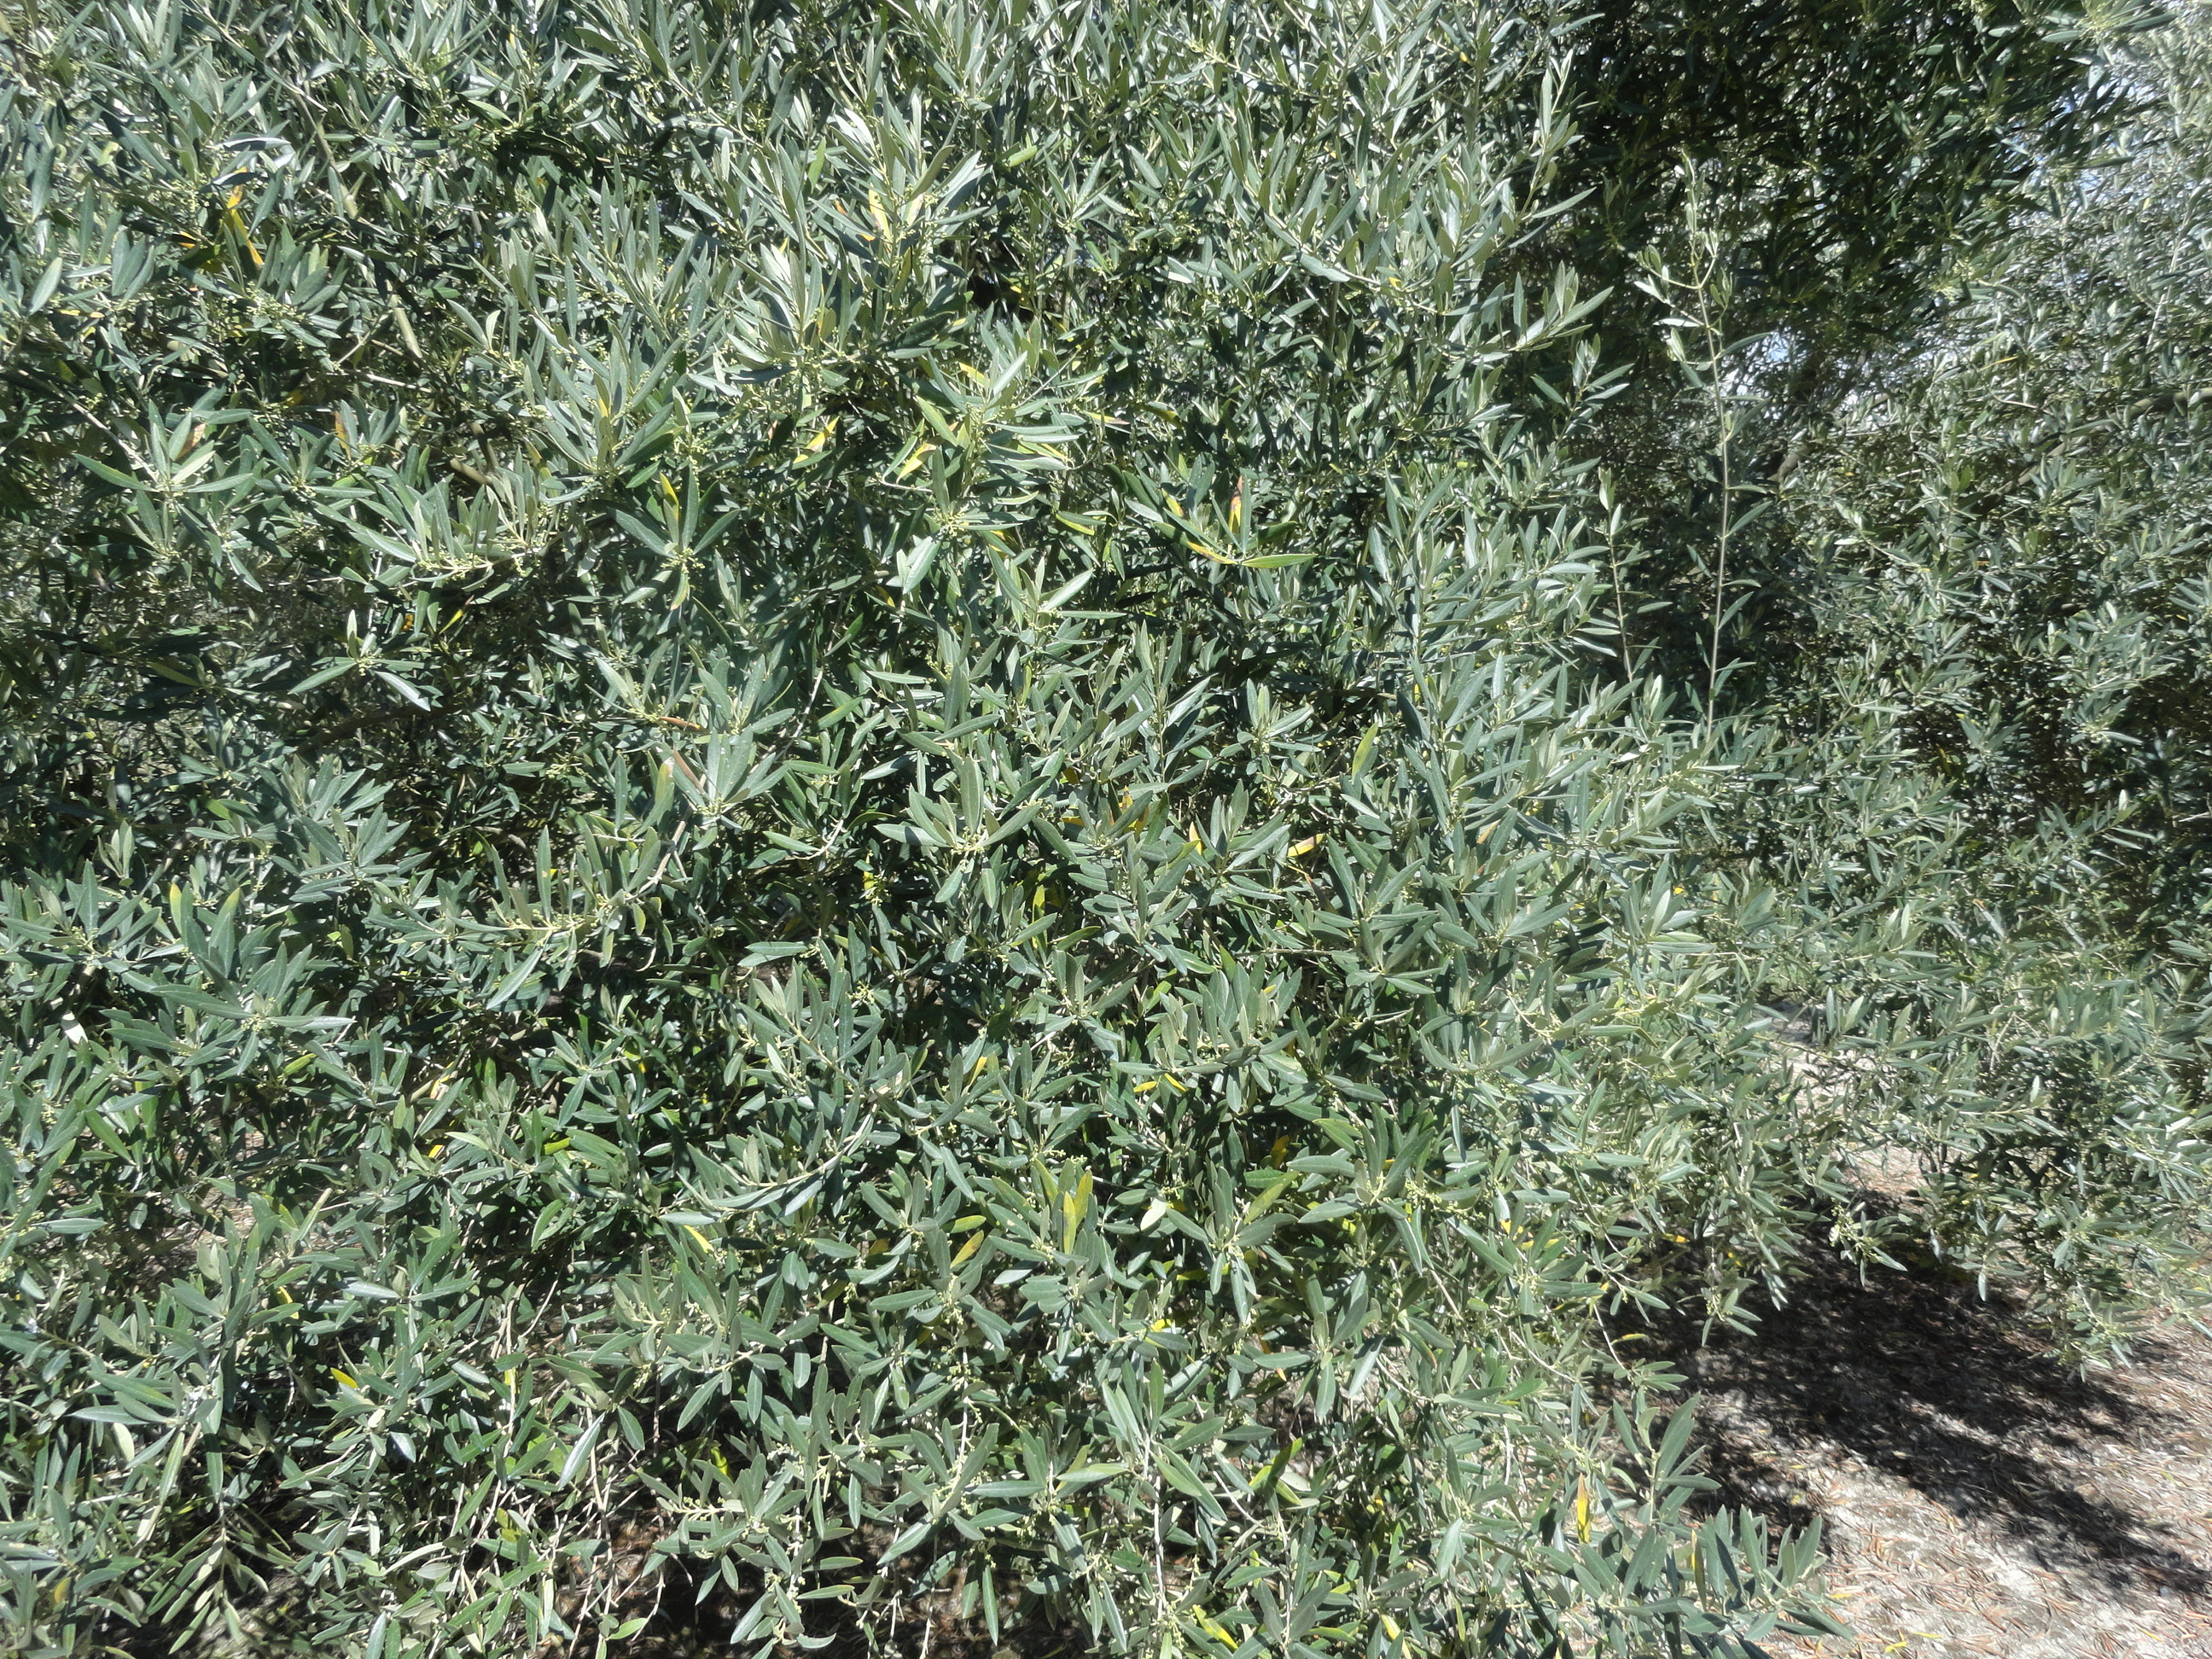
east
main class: Cropland
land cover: Olive groves
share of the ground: 50 - 75 %
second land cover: Spontaneously vegetated surfaces
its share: 10 - 25 %
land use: Agriculture (excluding fallow land and kitchen gardens)
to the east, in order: Olive groves; Spontaneously vegetated surfaces; Grassland without tree/shrub cover; Tracks; Grassland without tree/shrub cover; Paved roads, cycling and walking lanes; Ditches and canals; Grass margins; Olive groves
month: April
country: ES
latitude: 37.5485
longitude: -4.5046
